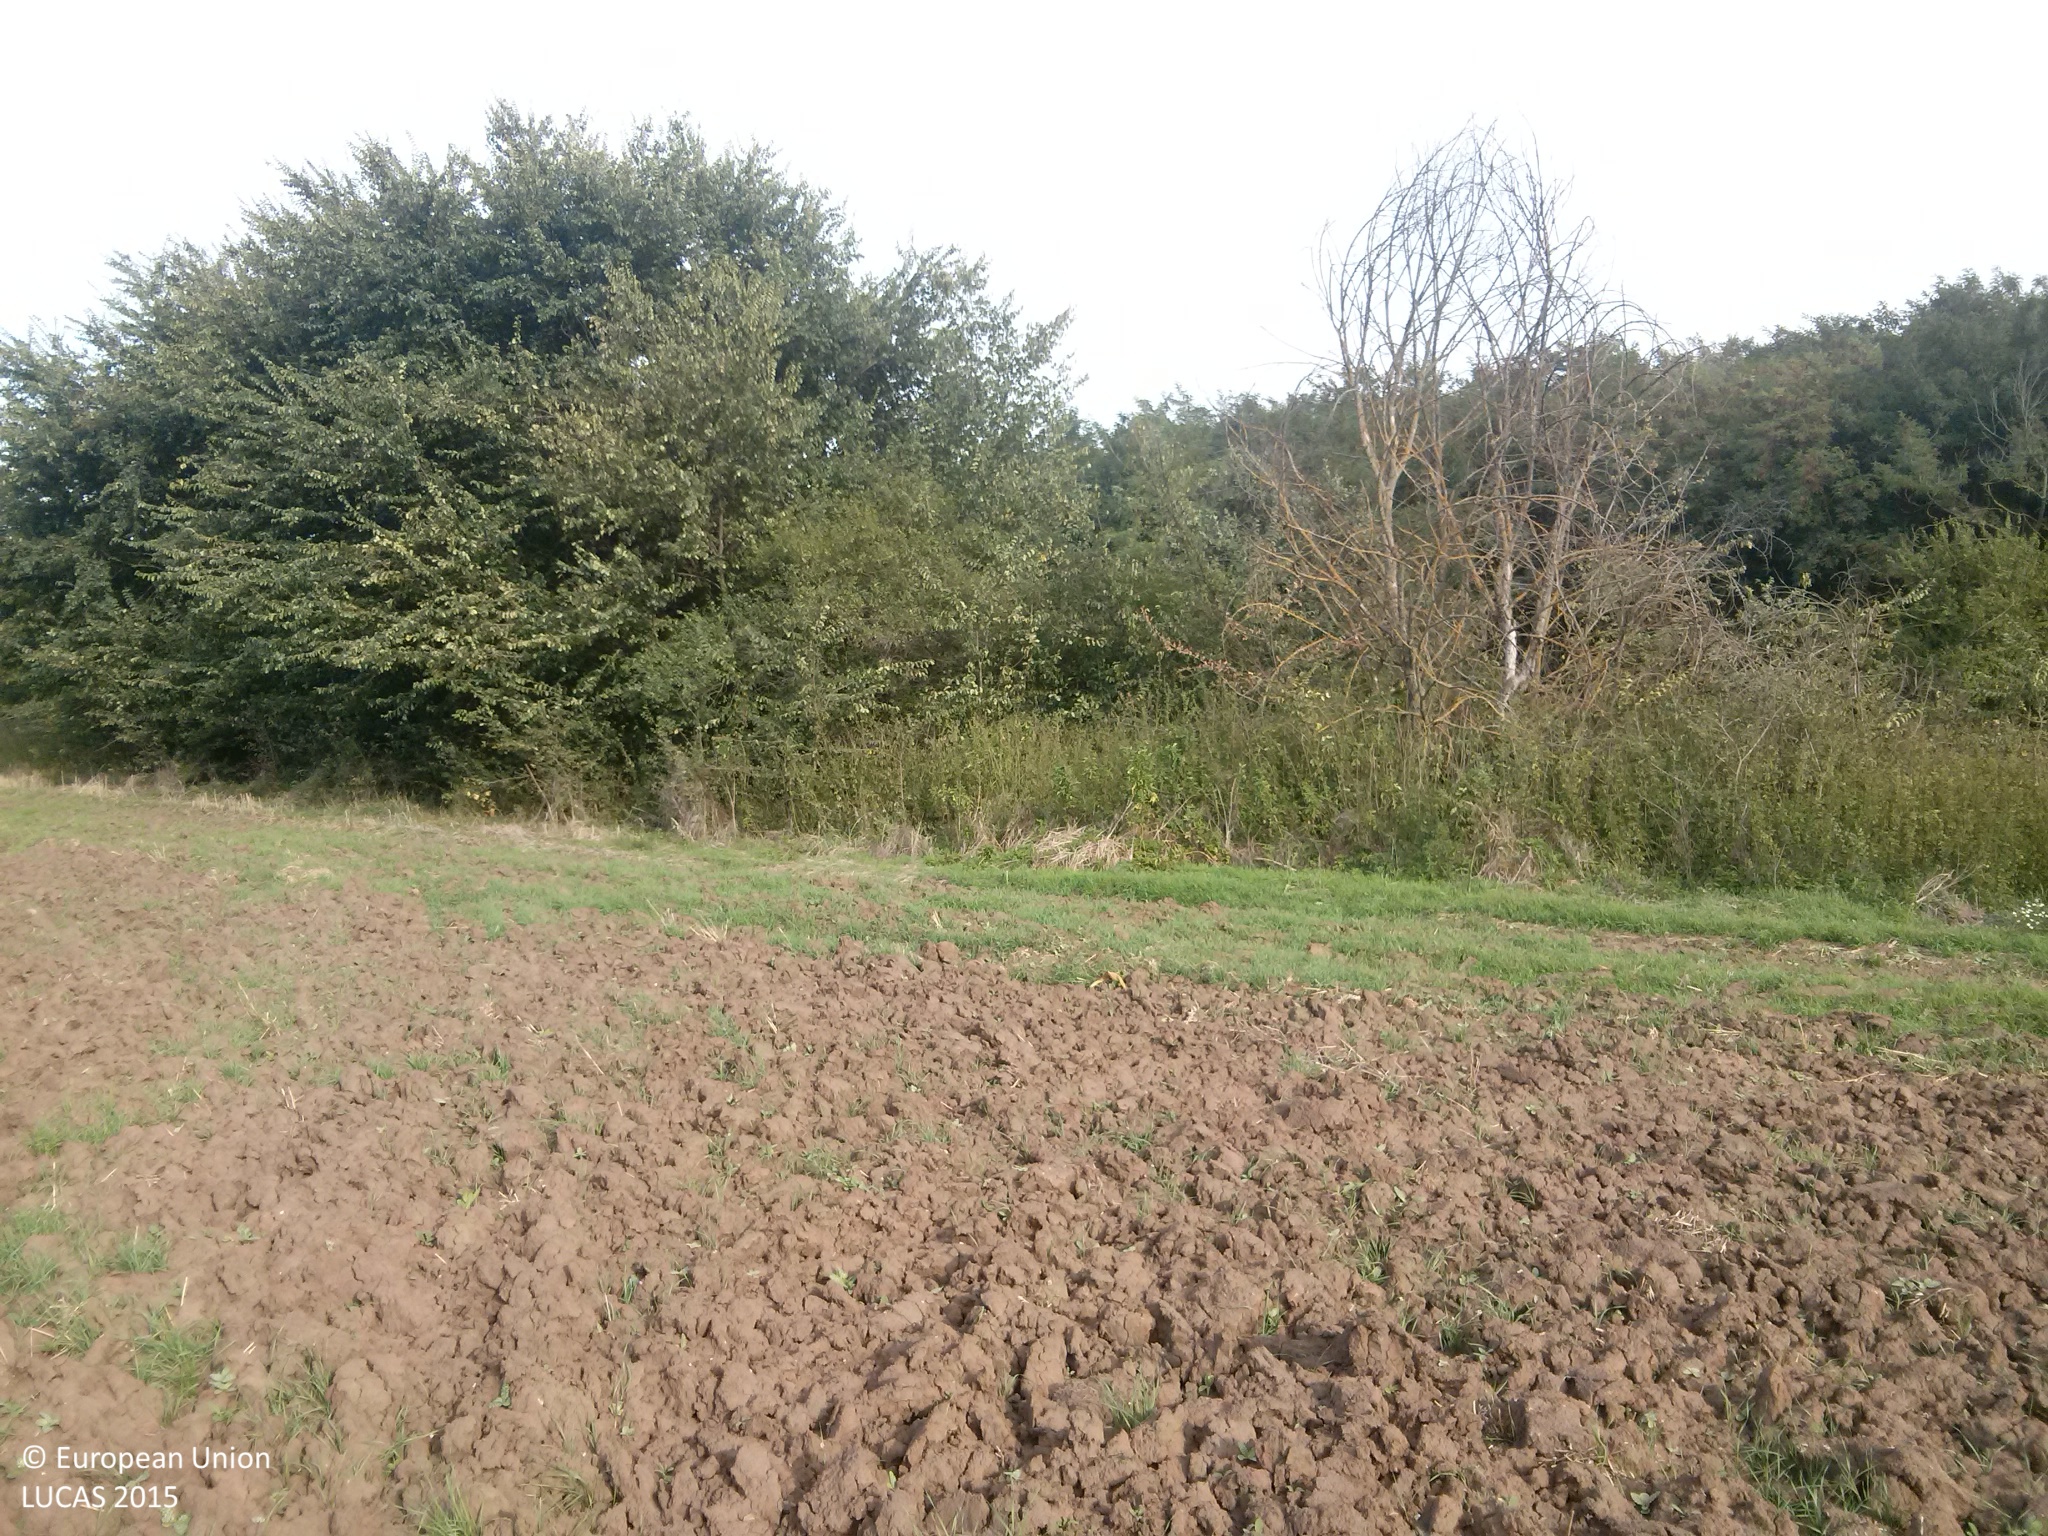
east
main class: Cropland
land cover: Common wheat
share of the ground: < 10 %
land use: Agriculture (excluding fallow land and kitchen gardens)
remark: Harvested field
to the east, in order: Common wheat; Broadleaved woodland; Grass margins; Paved roads, cycling and walking lanes; Grassland with sparse tree/shrub cover; Broadleaved woodland
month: September
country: BG
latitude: 43.7265
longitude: 26.3281
